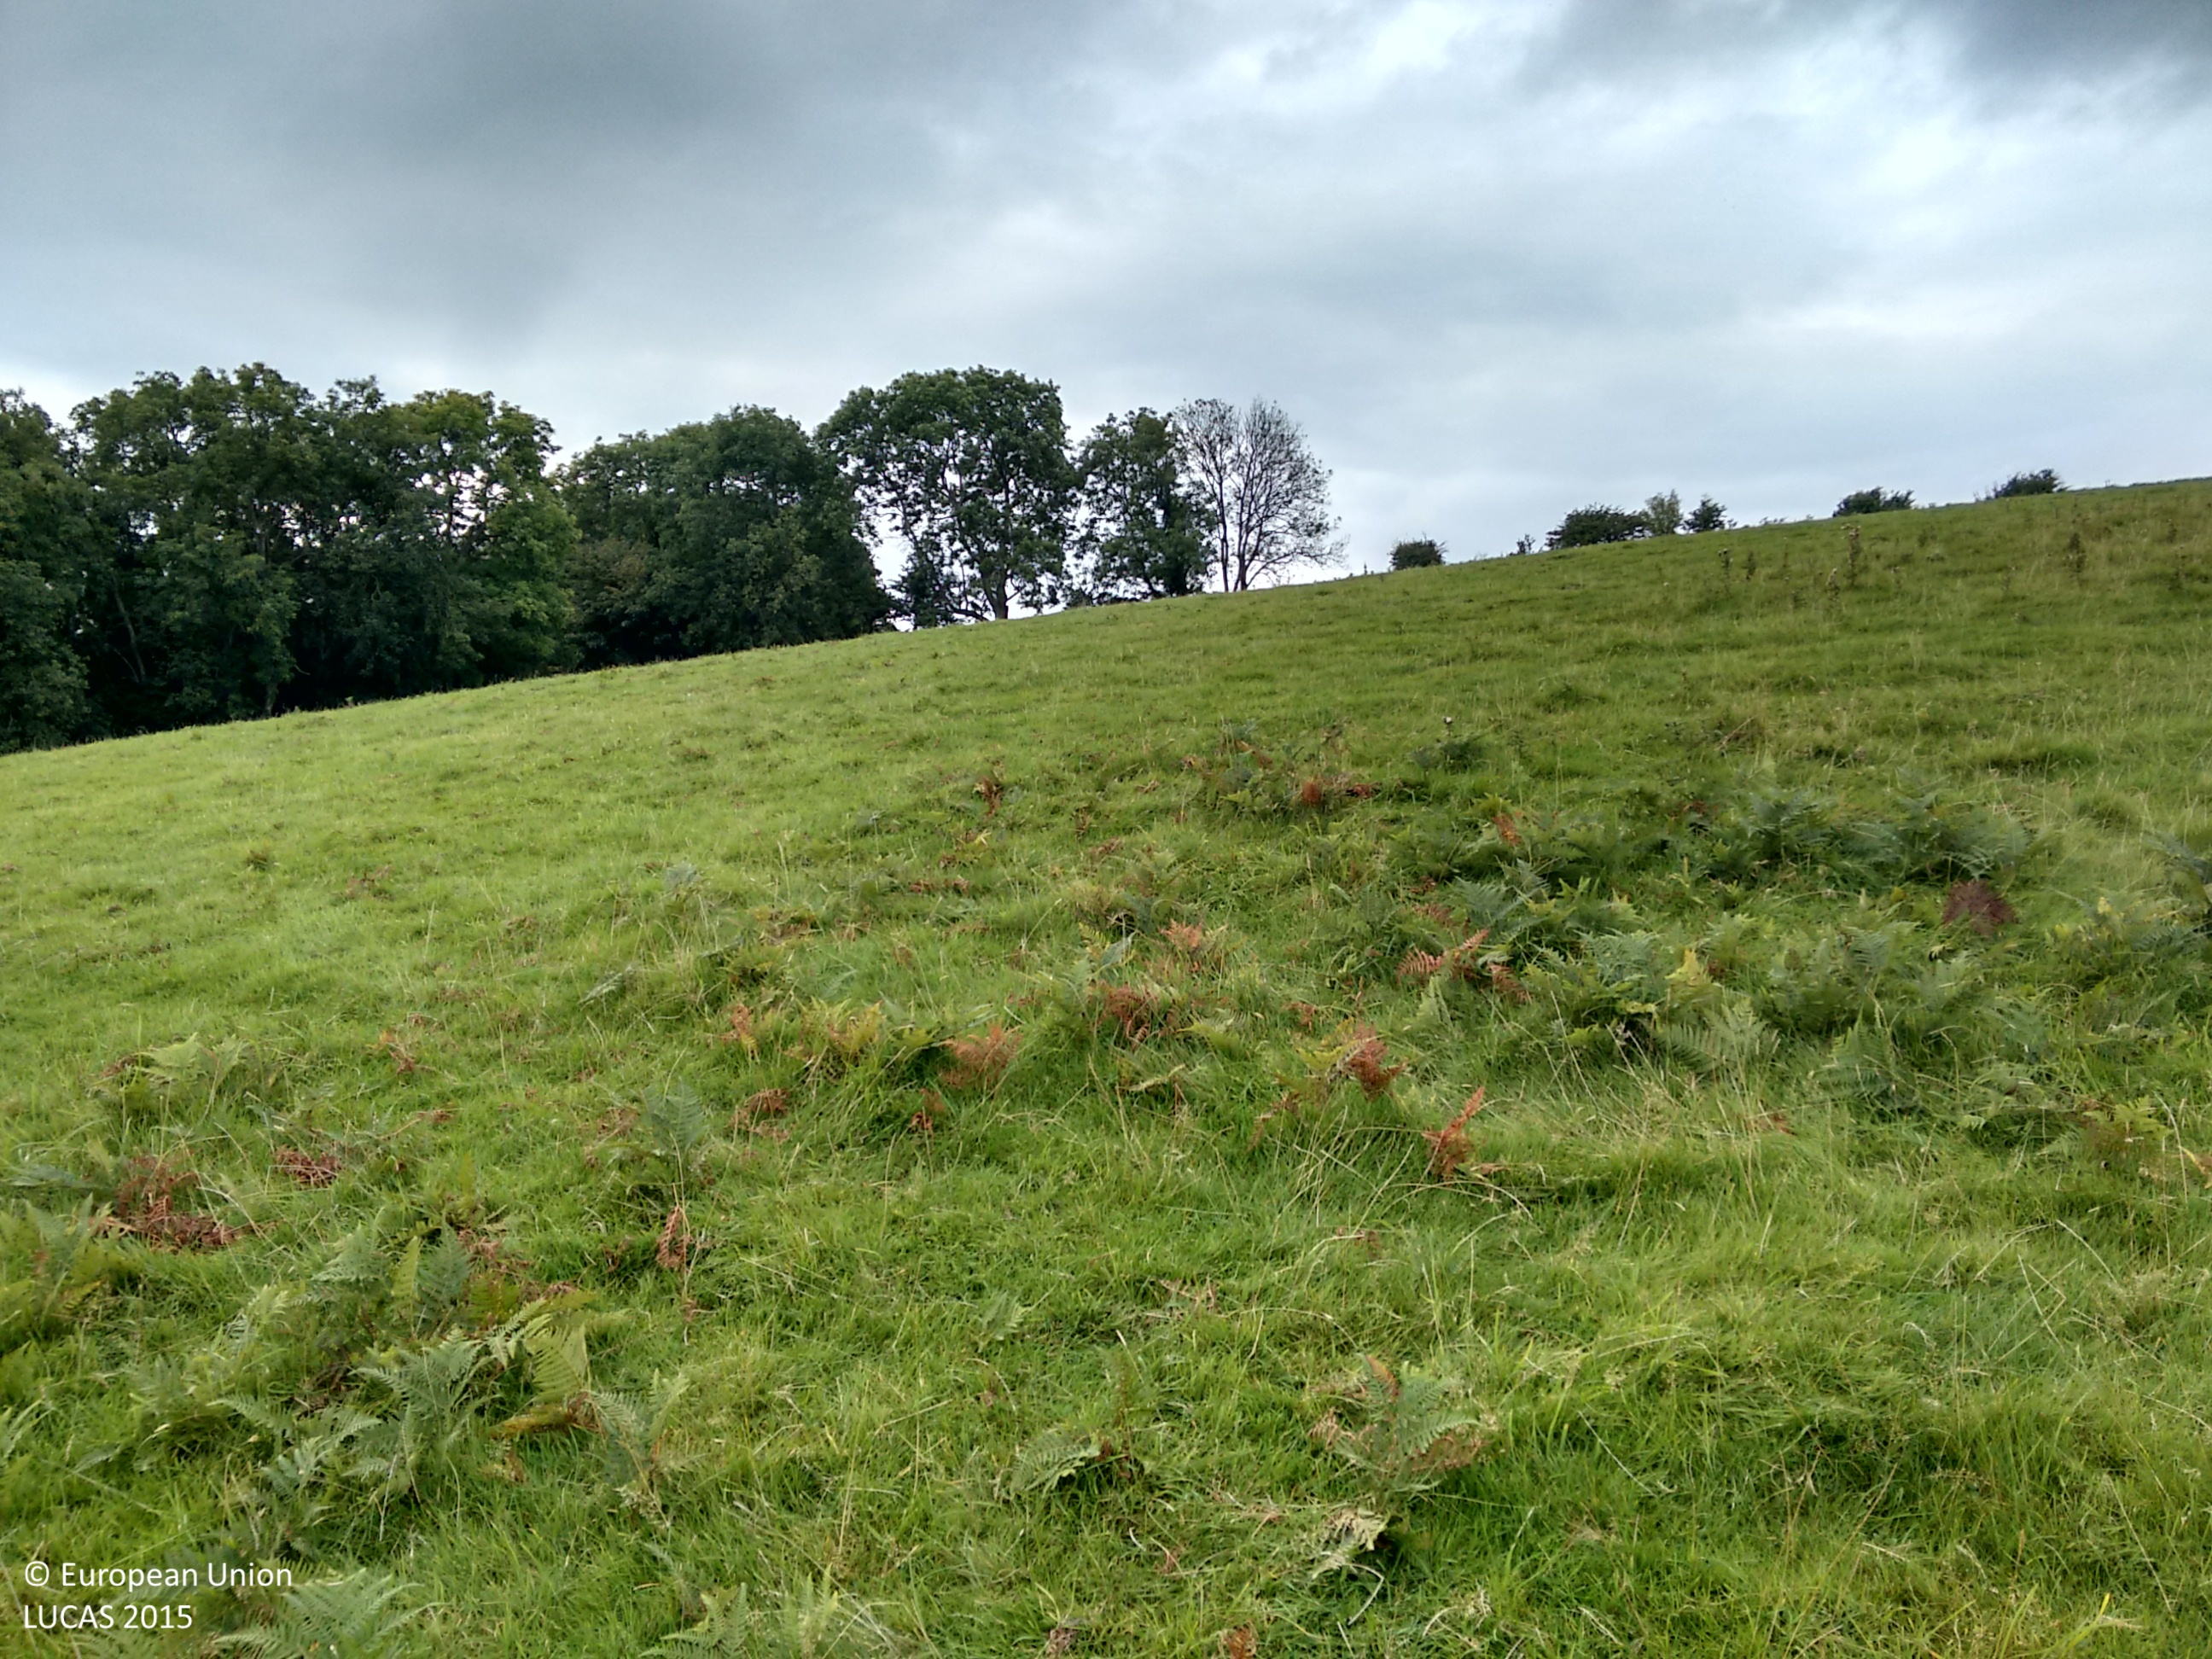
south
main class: Grassland
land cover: Grassland without tree/shrub cover
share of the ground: > 75 %
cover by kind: herbaceous plants 100 %
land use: Agriculture (excluding fallow land and kitchen gardens)
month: September
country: GB
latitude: 52.1320
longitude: -4.5549
